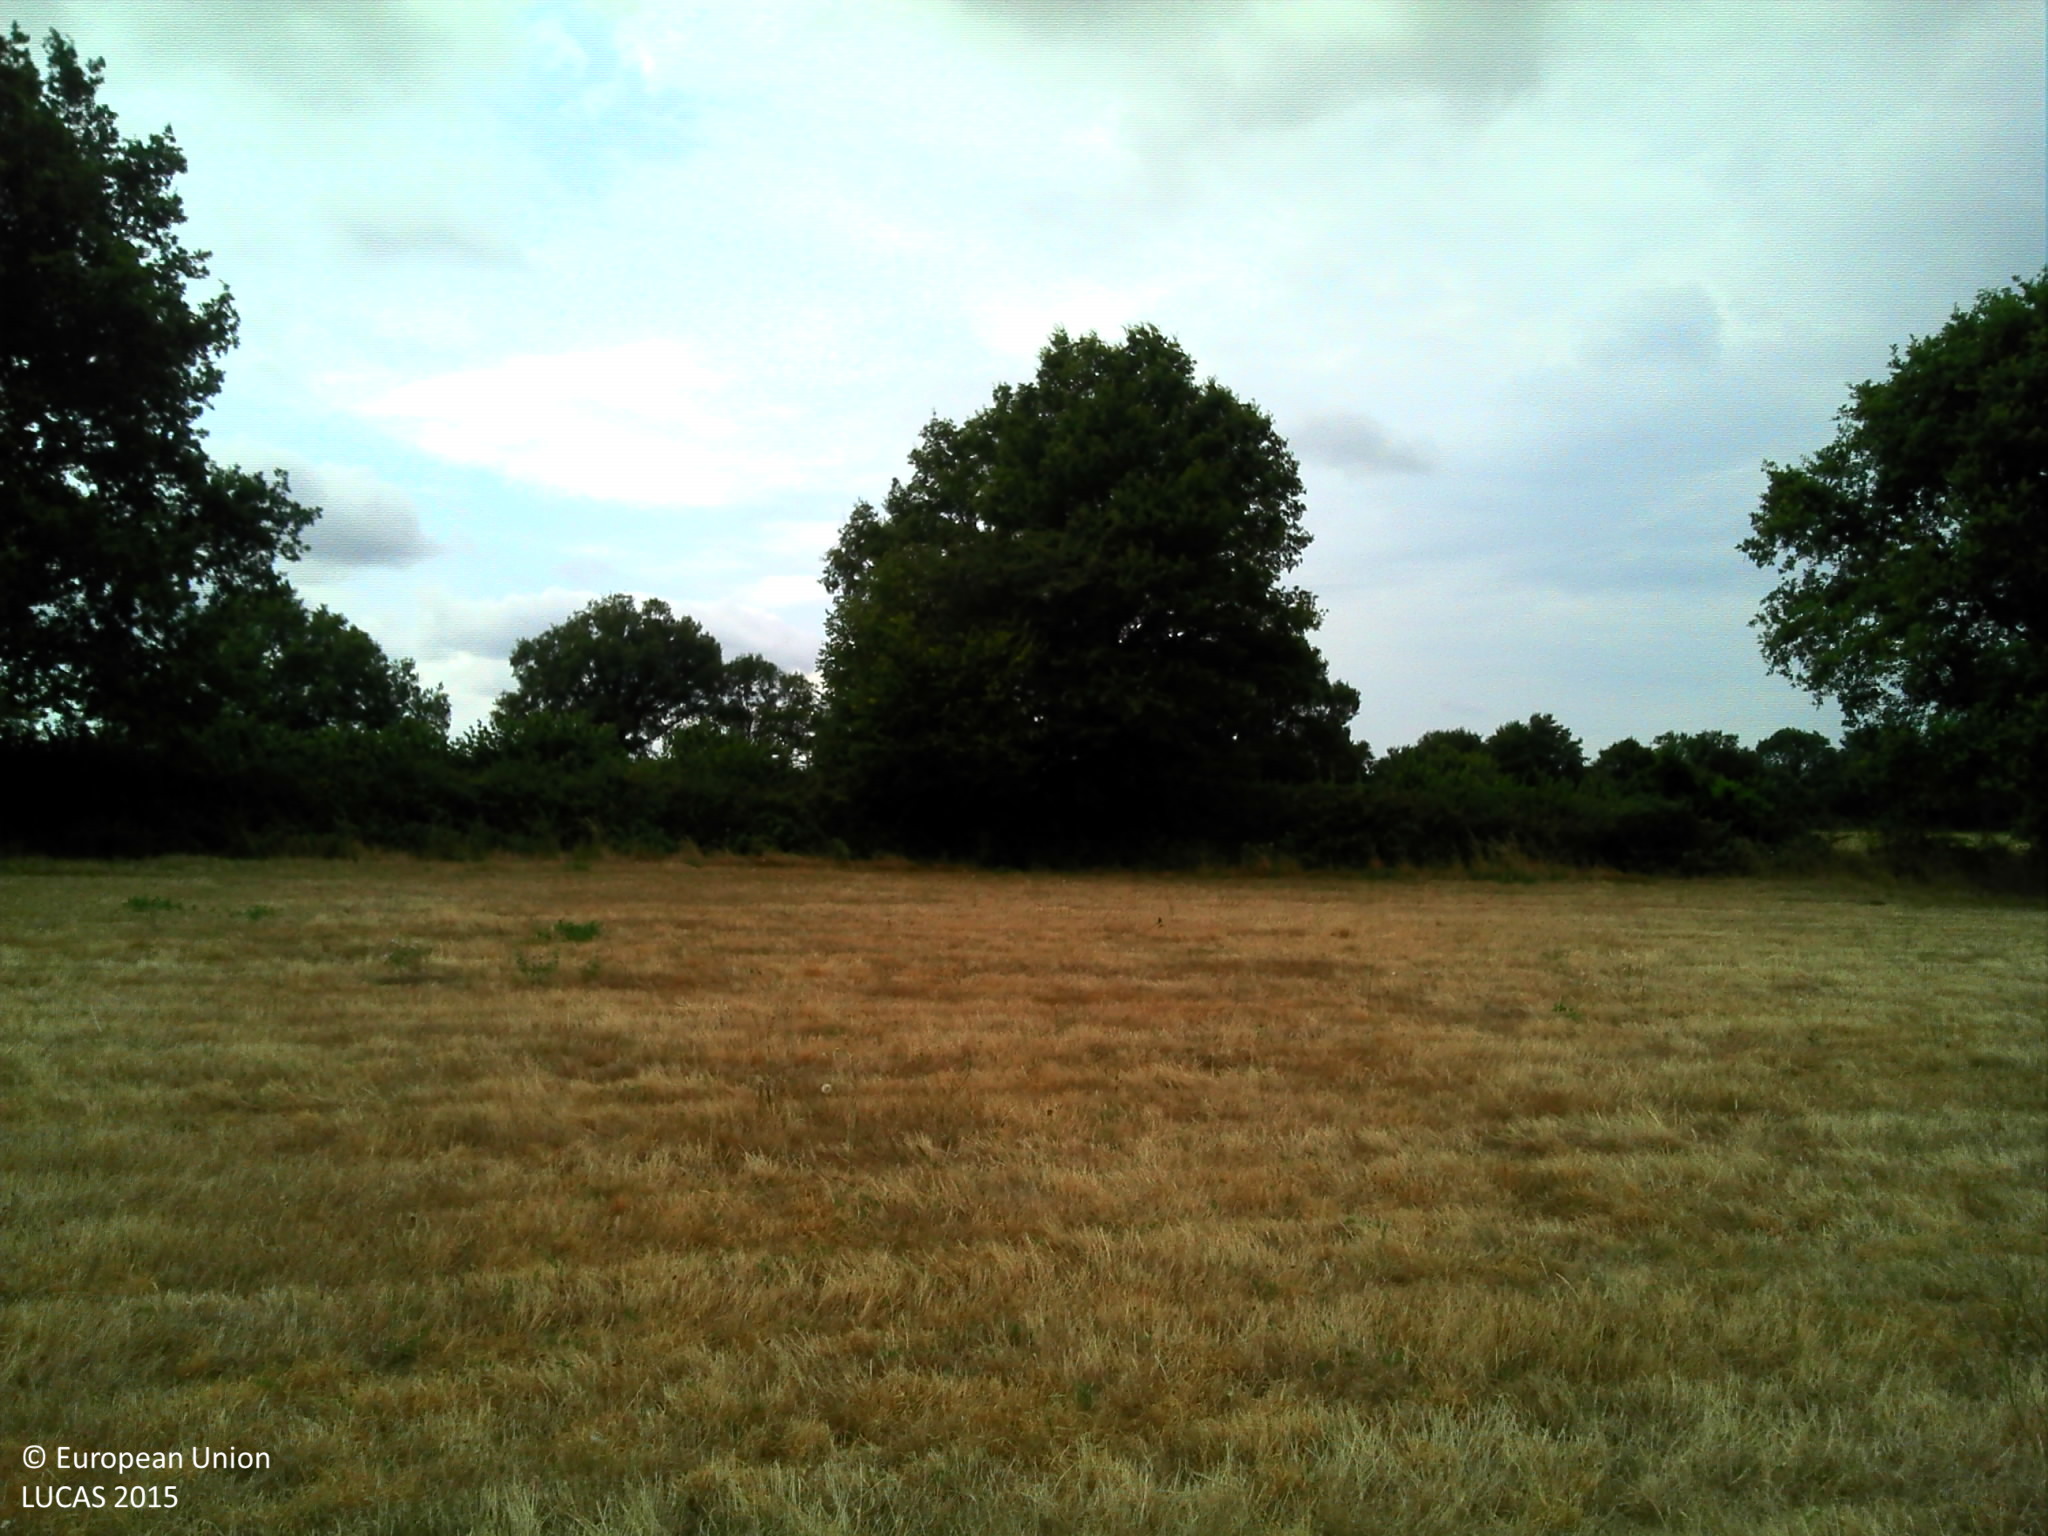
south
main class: Grassland
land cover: Grassland without tree/shrub cover
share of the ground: > 75 %
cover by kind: herbaceous plants 100 %
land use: Agriculture (excluding fallow land and kitchen gardens)
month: July
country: FR
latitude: 46.6105
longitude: 3.0115
